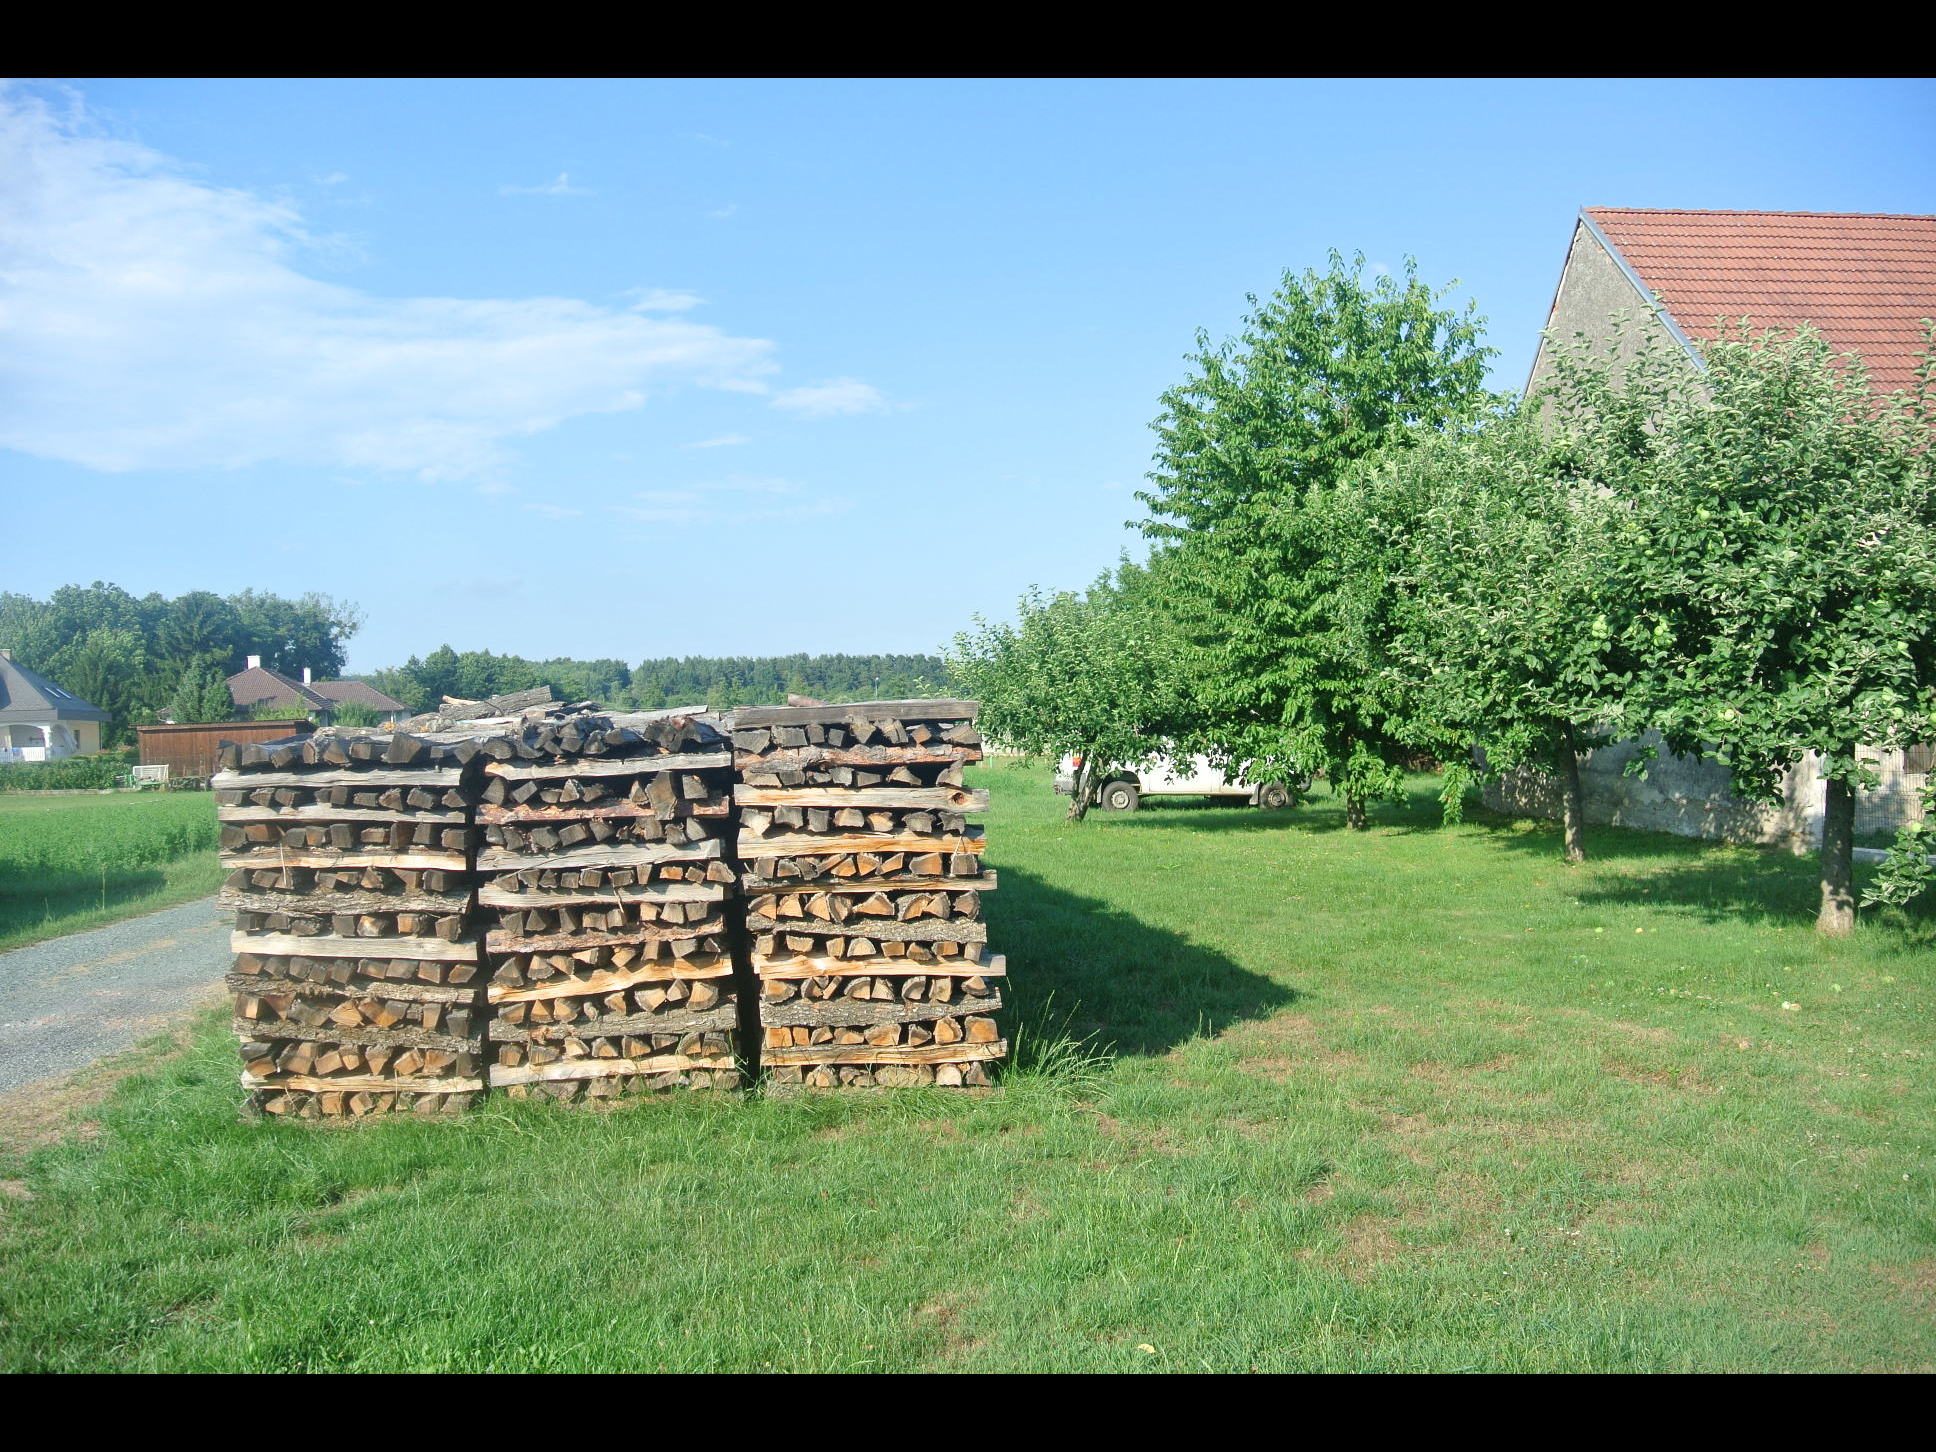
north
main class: Grassland
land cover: Grassland without tree/shrub cover
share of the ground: > 75 %
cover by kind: herbaceous plants 100 %
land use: Residential
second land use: Agriculture (excluding fallow land and kitchen gardens)
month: July
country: AT
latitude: 47.4725
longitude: 16.4919
